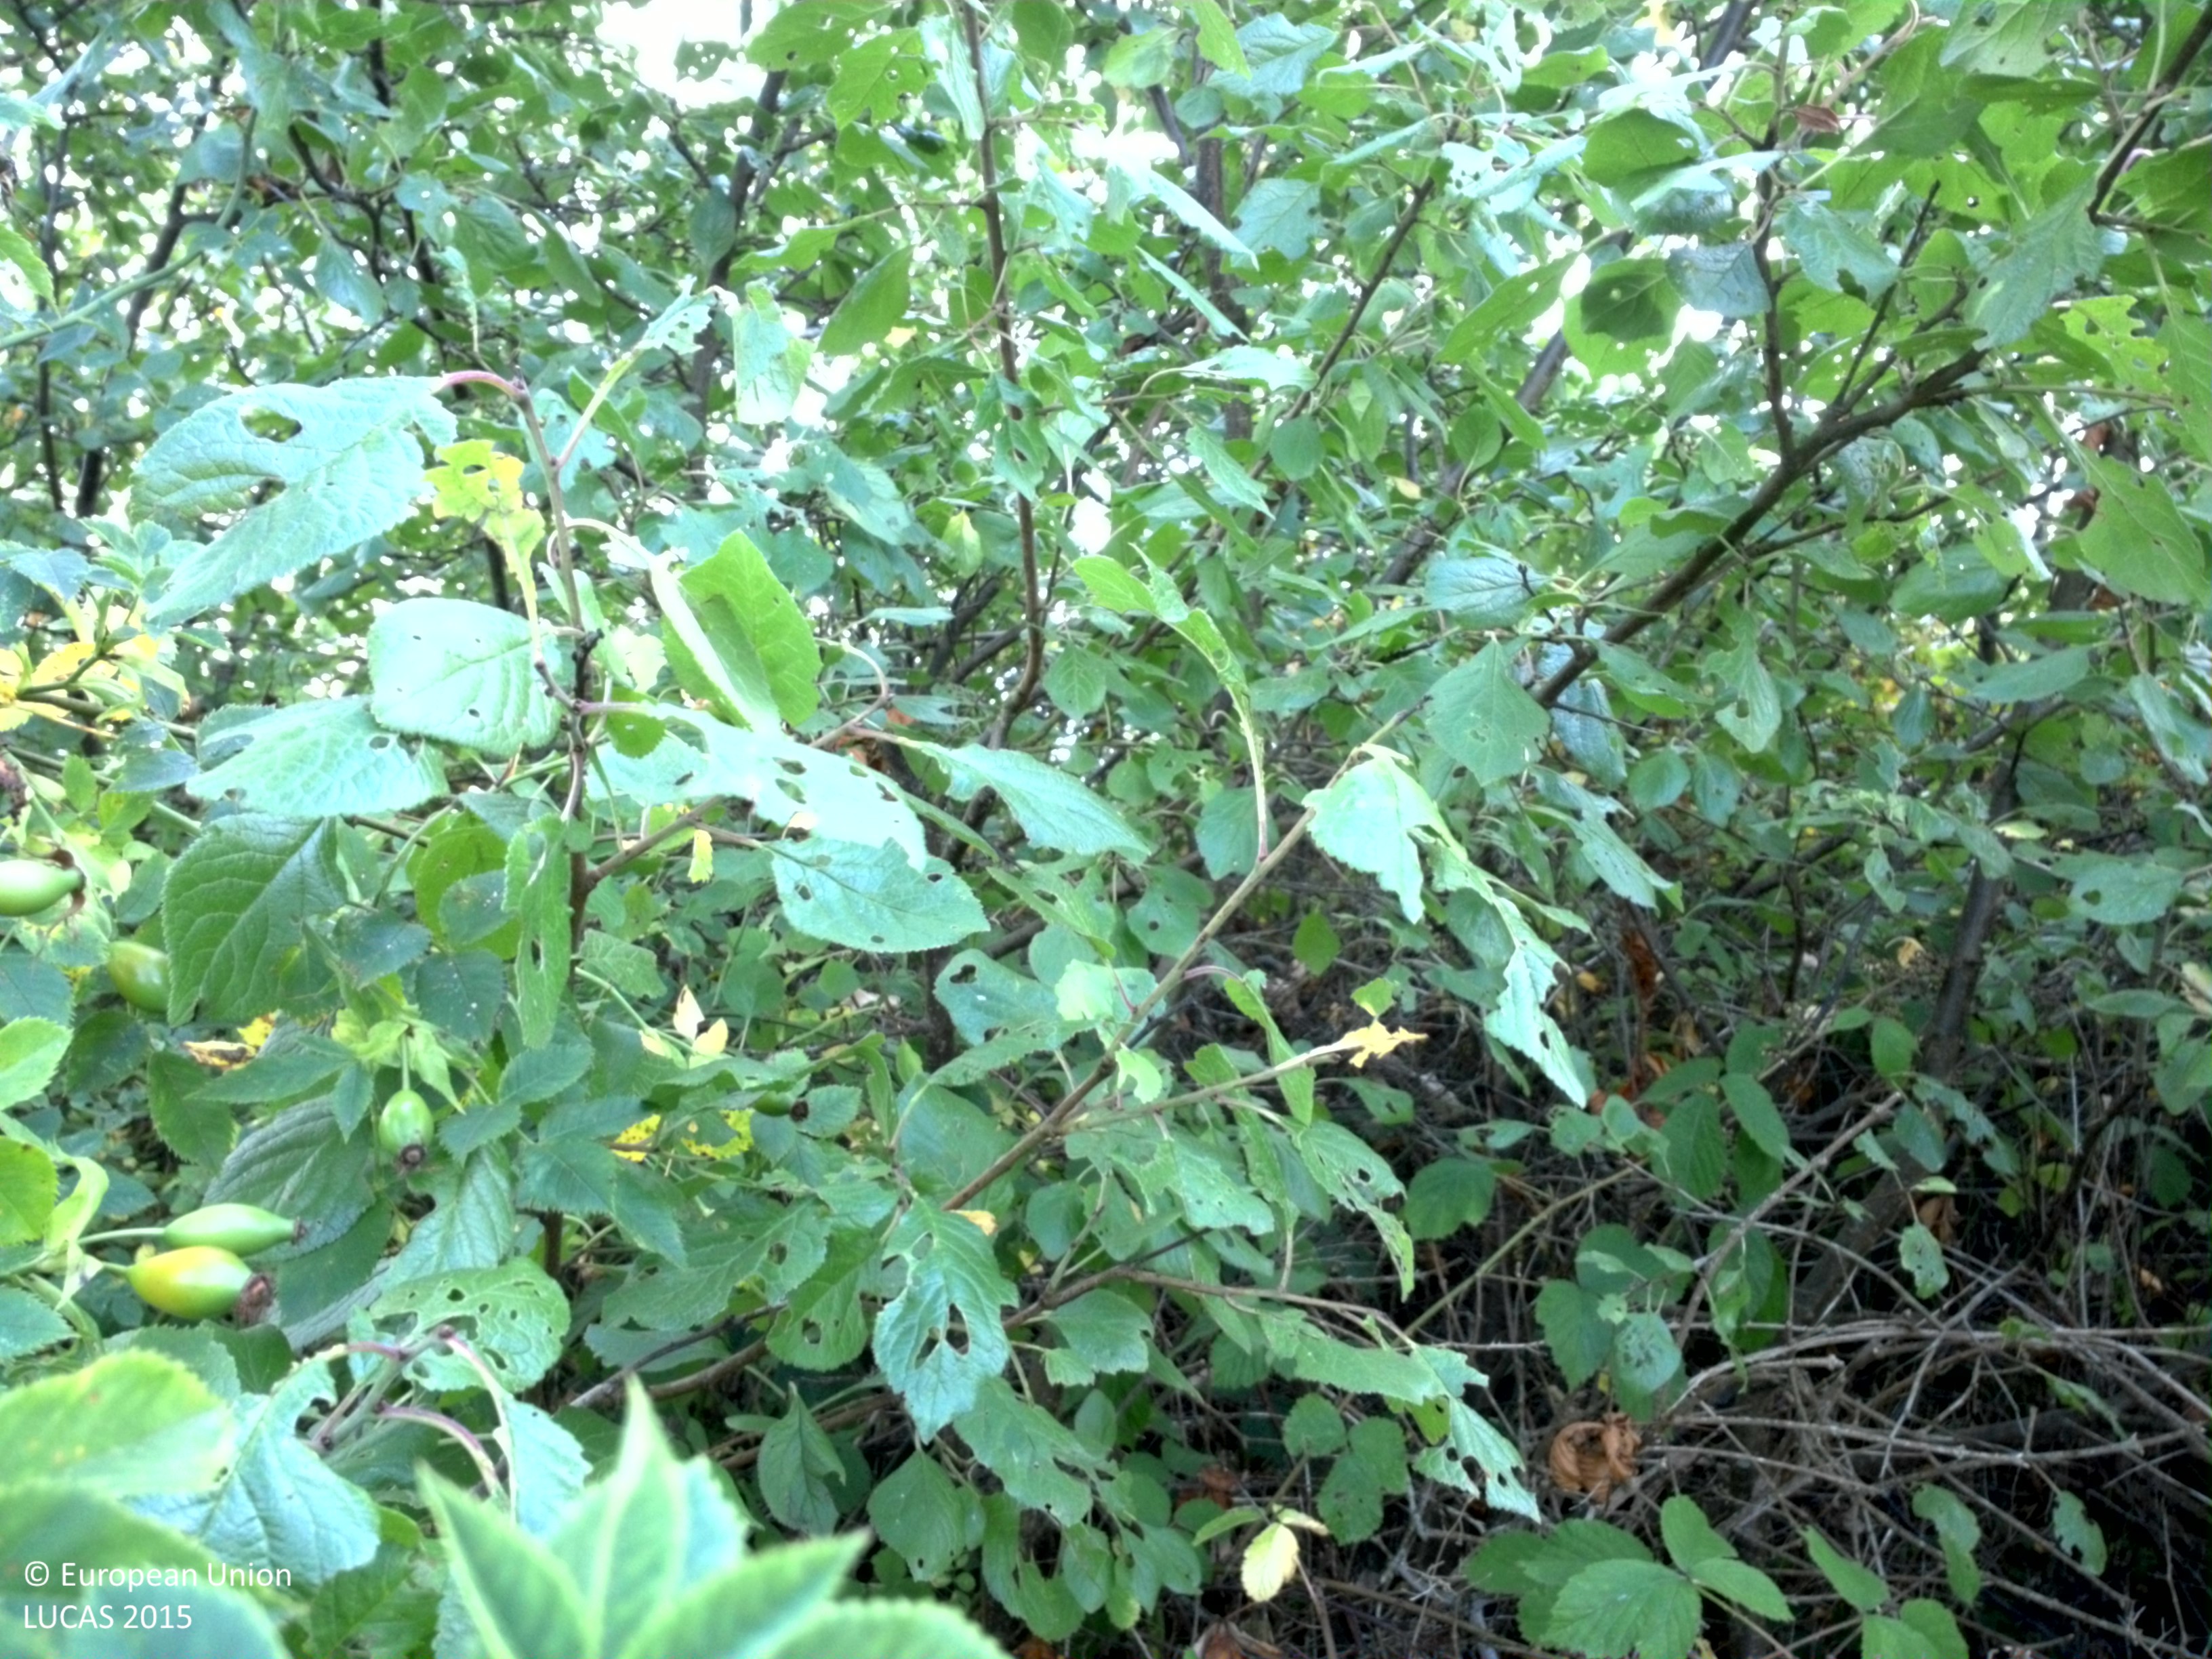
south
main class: Shrubland
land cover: Shrubland with sparse tree cover
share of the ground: > 75 %
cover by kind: shrubs 90 %, broadleaved forest trees 5 %, herbaceous plants 5 %
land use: Residential
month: September
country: SE
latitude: 55.5378
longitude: 14.3564
